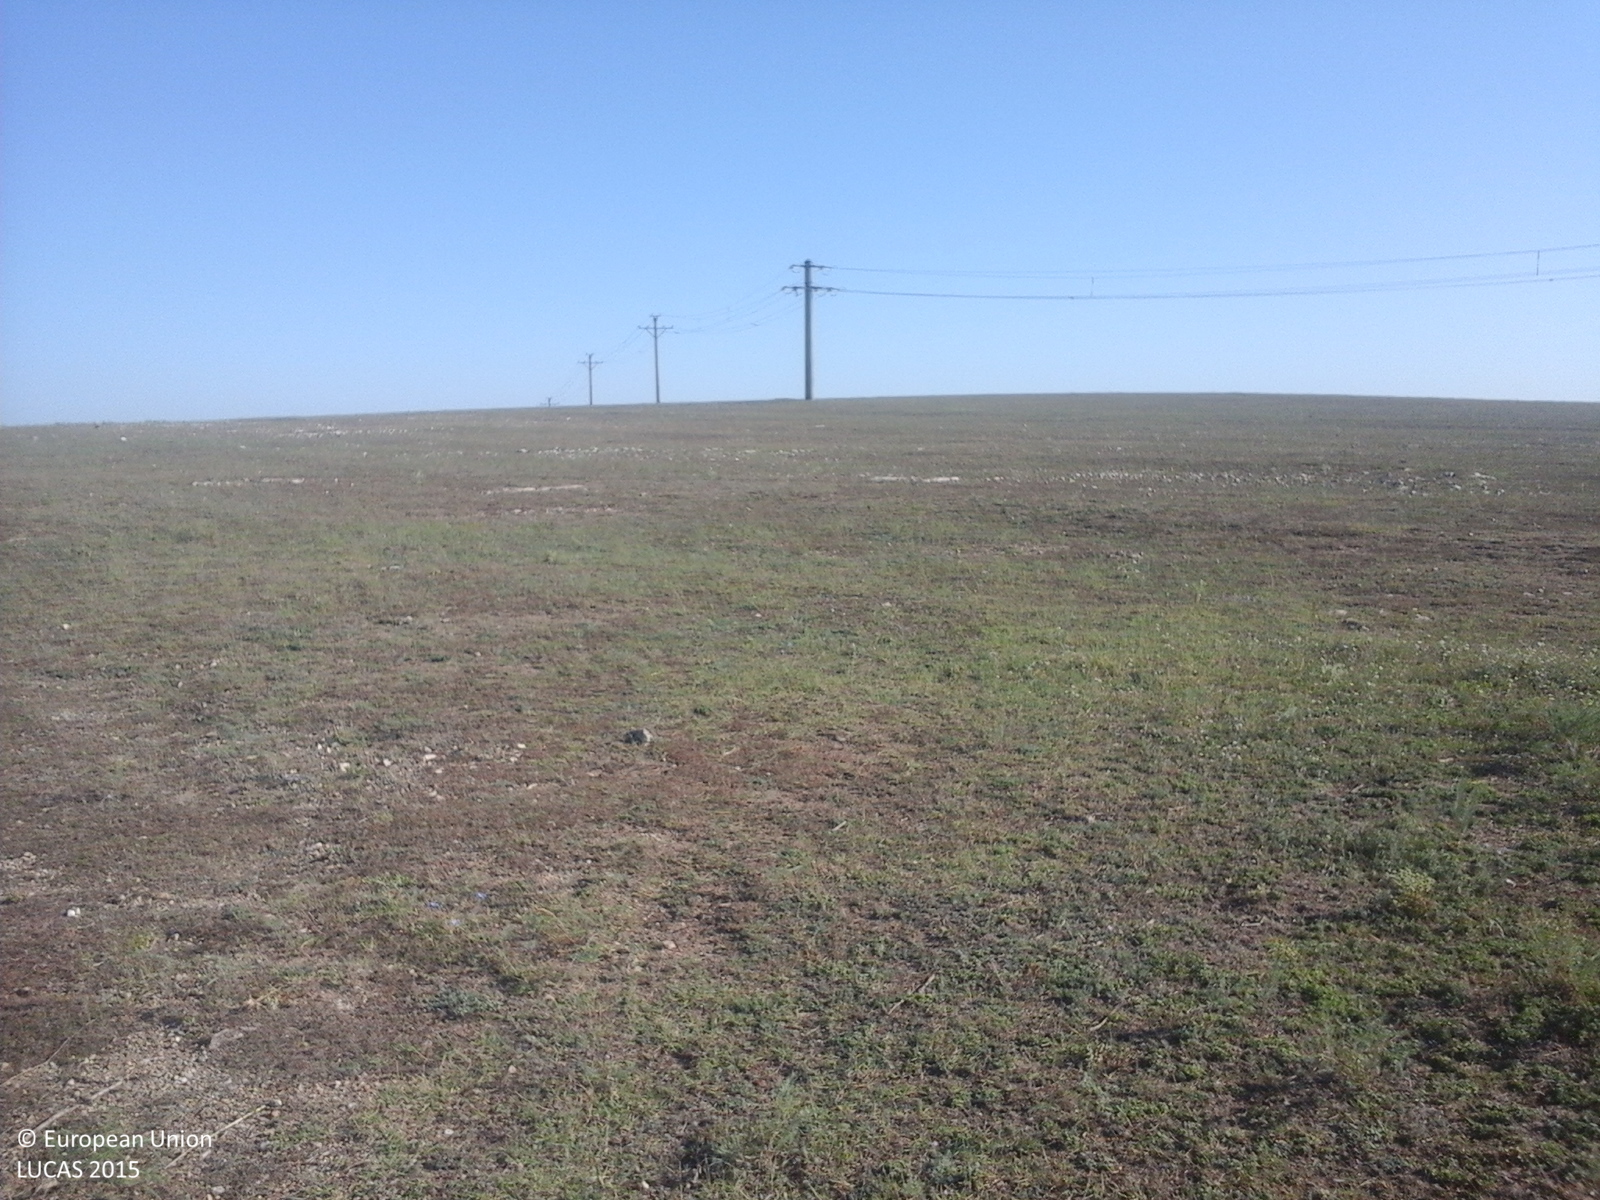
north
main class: Grassland
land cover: Grassland without tree/shrub cover
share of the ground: > 75 %
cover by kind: herbaceous plants 100 %
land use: Agriculture (excluding fallow land and kitchen gardens)
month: August
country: RO
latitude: 44.3930
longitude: 28.5663
